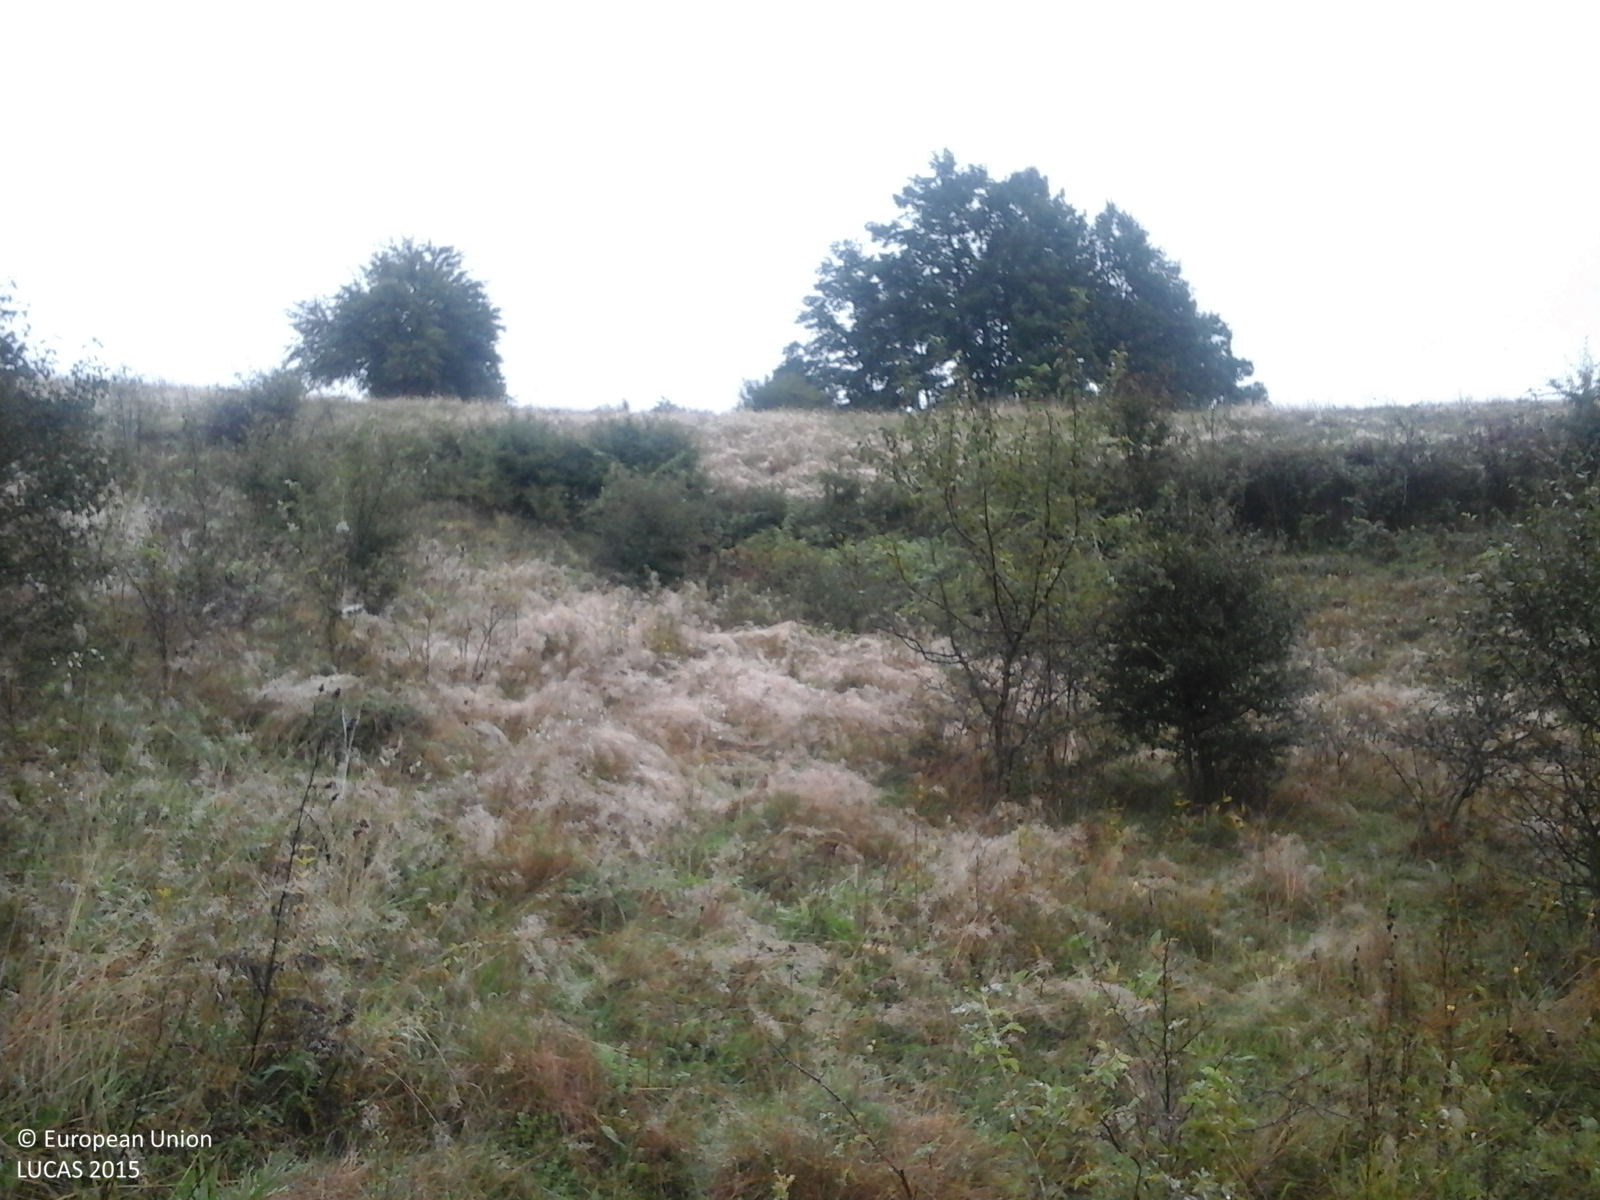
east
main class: Shrubland
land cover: Shrubland with sparse tree cover
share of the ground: > 75 %
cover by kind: herbaceous plants 85 %, shrubs 10 %, broadleaved forest trees 5 %
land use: Fallow land
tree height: < 5 m
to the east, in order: Shrubland with sparse tree cover; Spontaneously vegetated surfaces; Single bushes/trees; Grassland without tree/shrub cover; Shrubland with sparse tree cover; Tracks; Shrubland with sparse tree cover; Tracks; Shrubland with sparse tree cover; Tracks; Shrubland with sparse tree cover
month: September
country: RO
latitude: 46.9509
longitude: 22.4434
